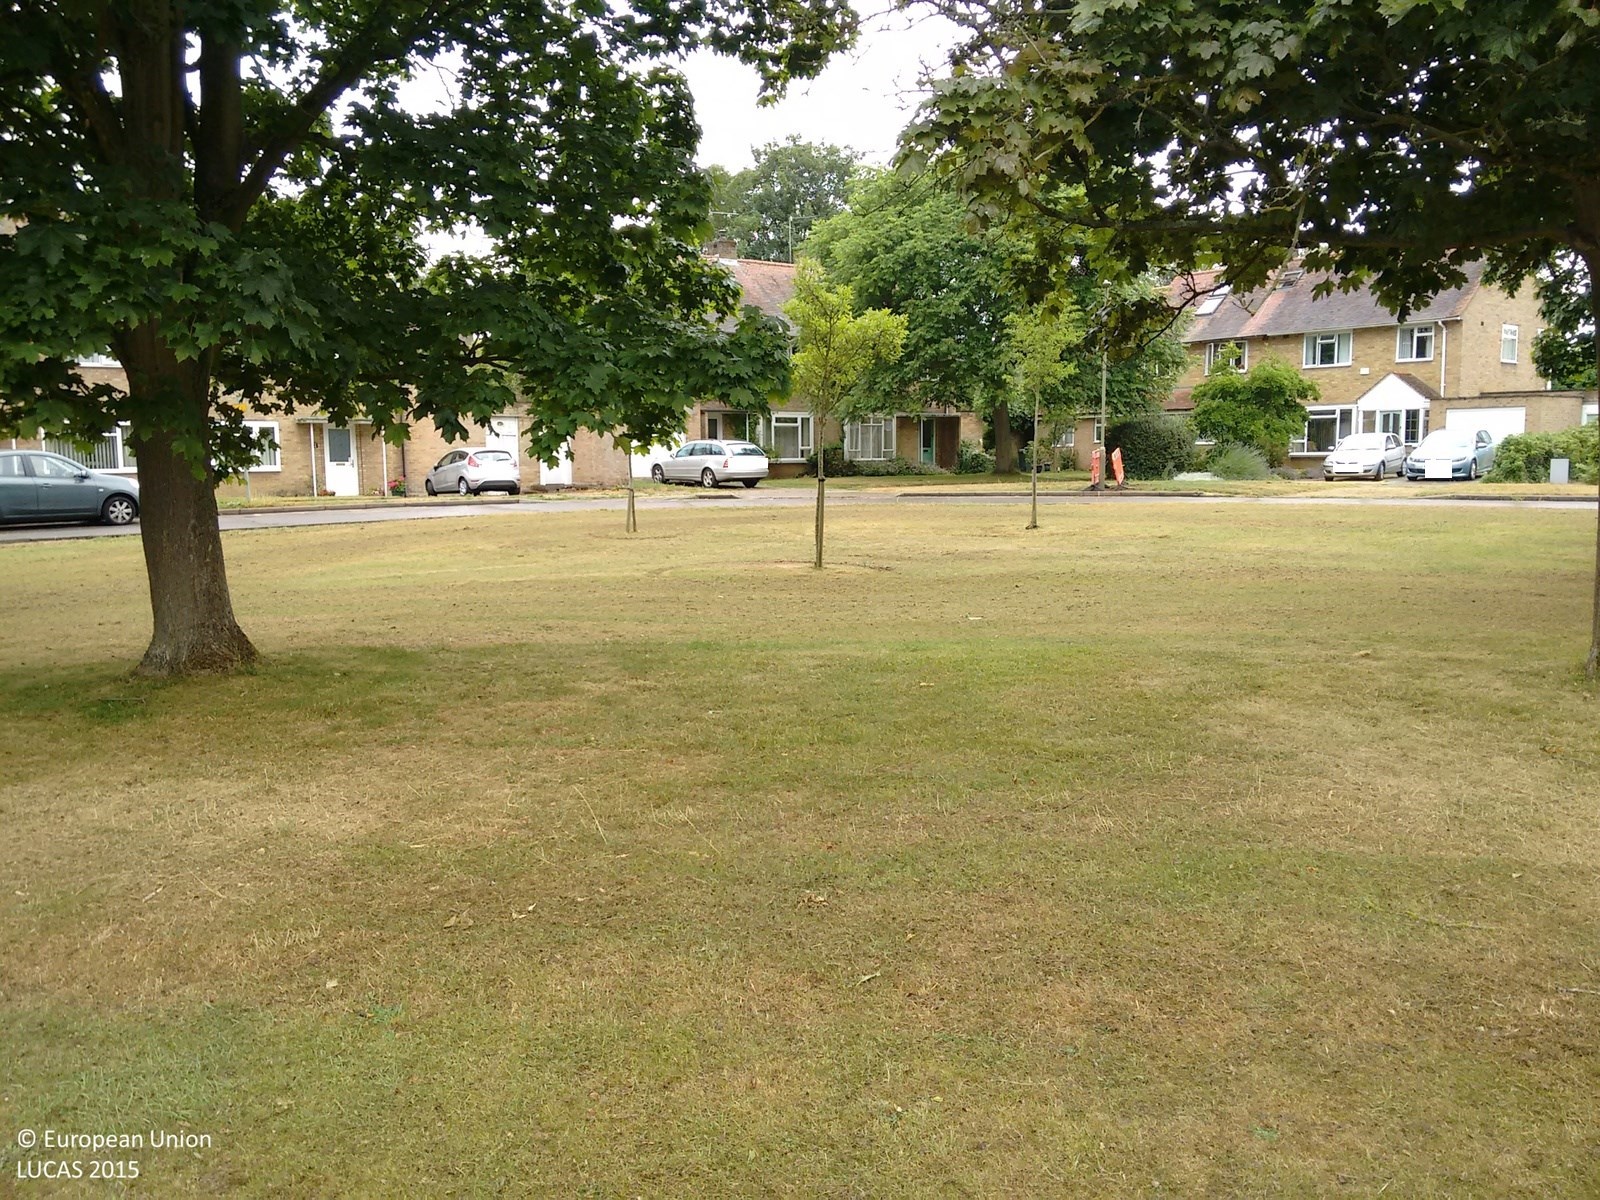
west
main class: Grassland
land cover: Grassland with sparse tree/shrub cover
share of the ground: > 75 %
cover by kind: herbaceous plants 95 %, broadleaved forest trees 5 %
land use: Residential
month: July
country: GB
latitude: 51.6740
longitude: -1.2842
